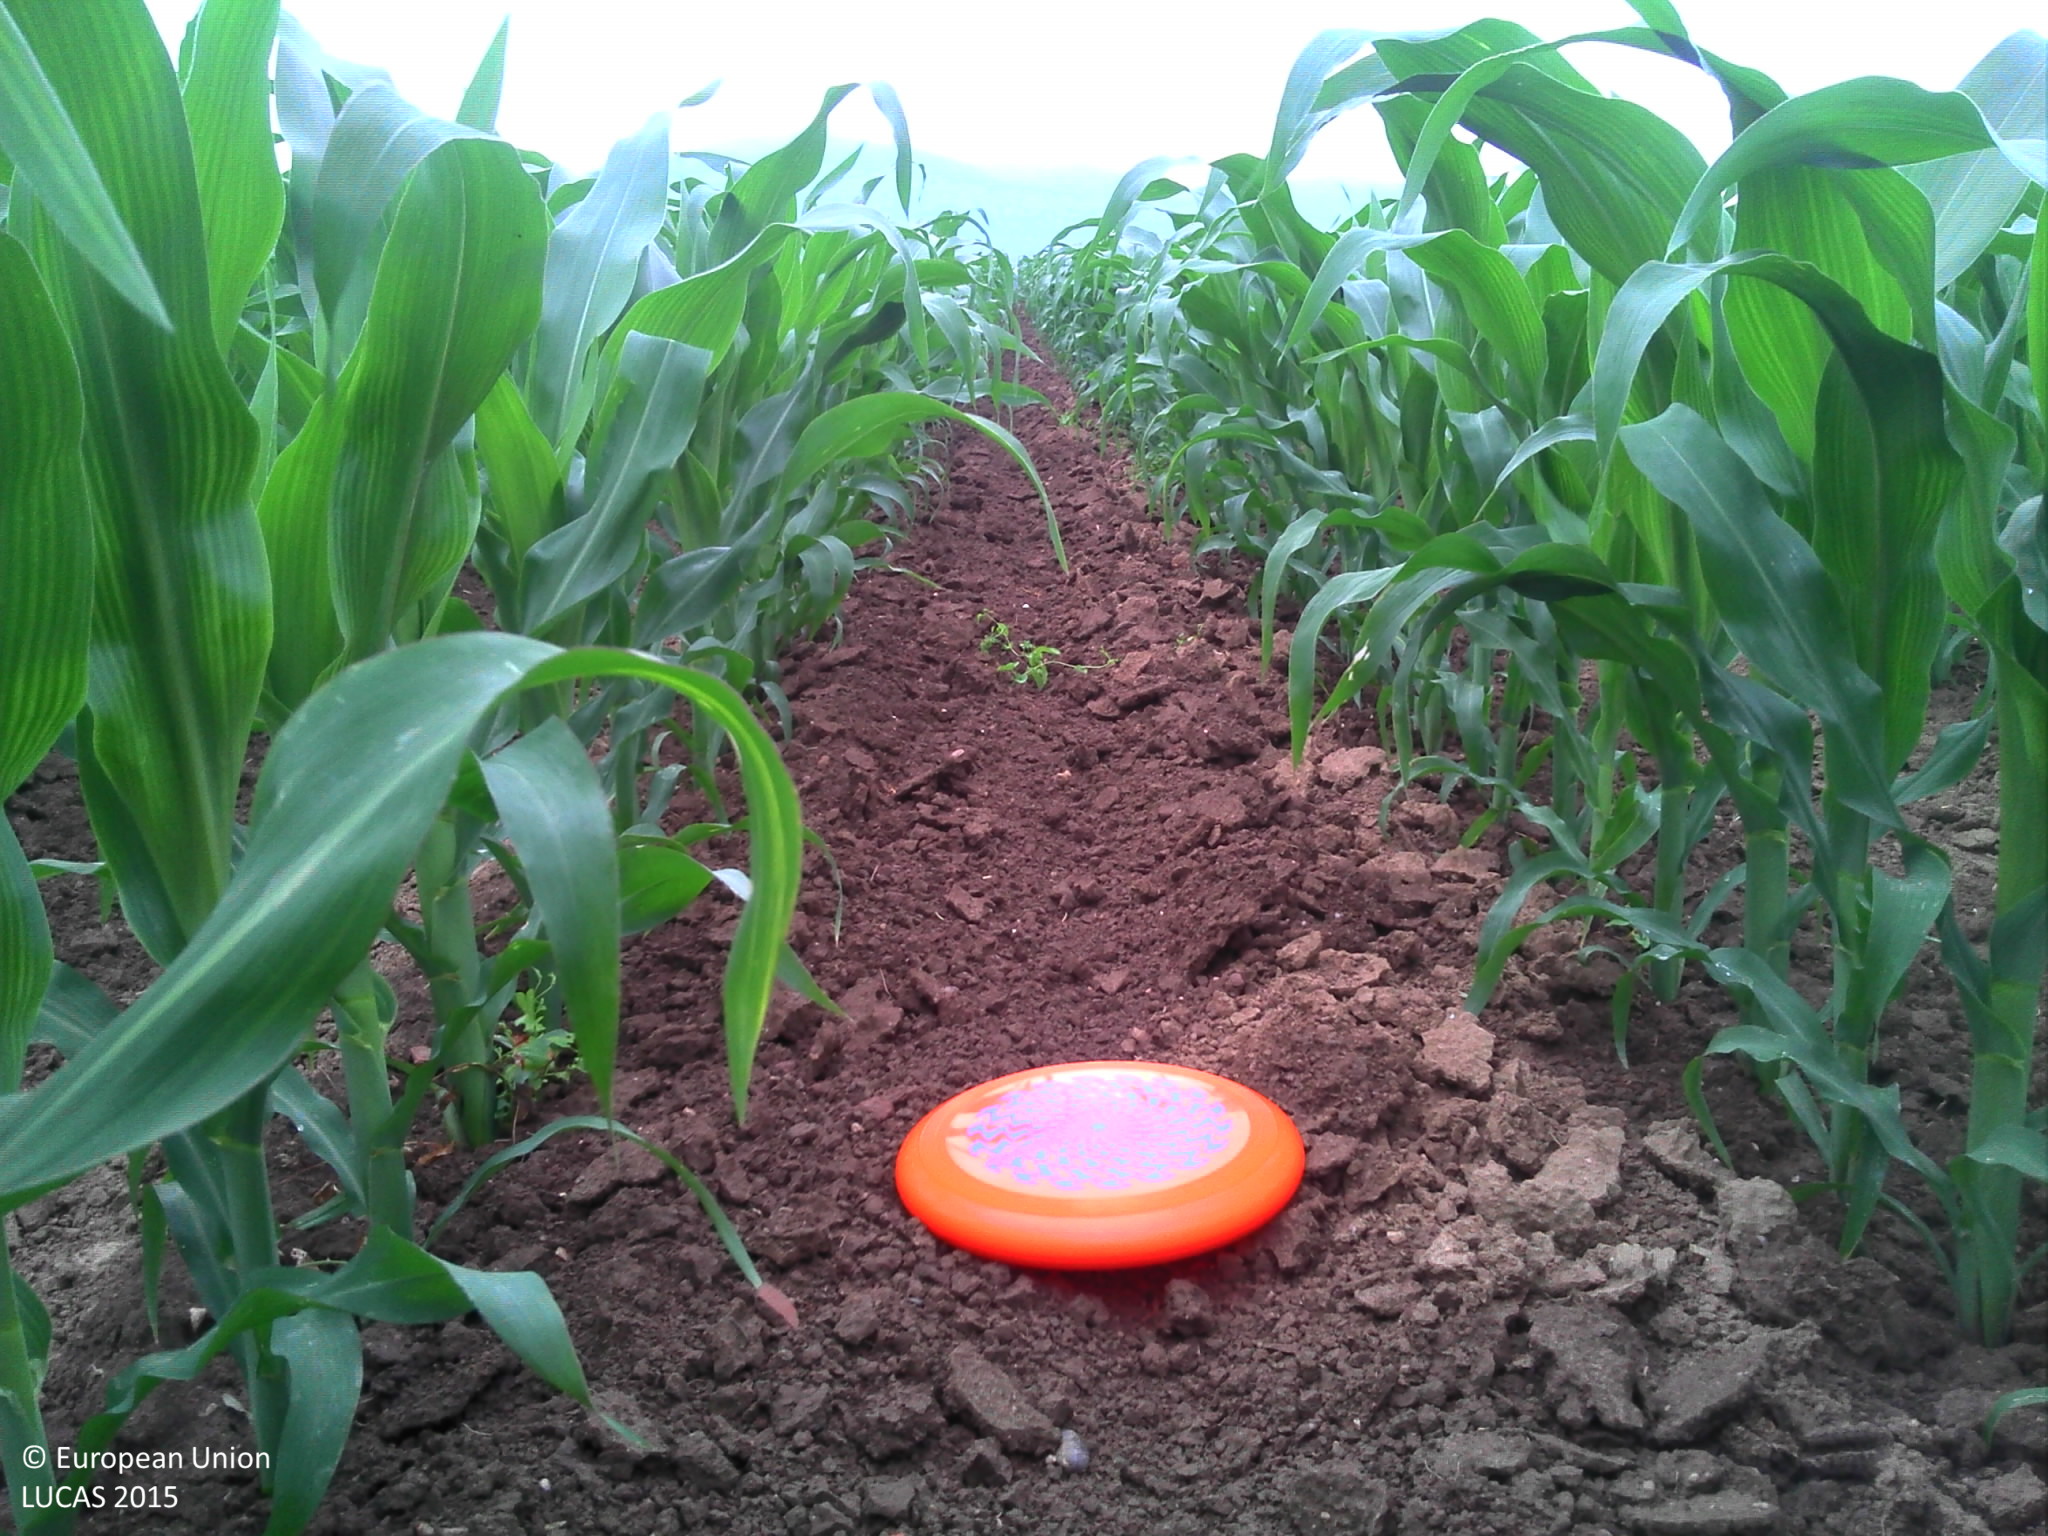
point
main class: Cropland
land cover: Maize
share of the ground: 10 - 25 %
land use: Agriculture (excluding fallow land and kitchen gardens)
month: June
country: FR
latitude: 48.4299
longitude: 7.5276
